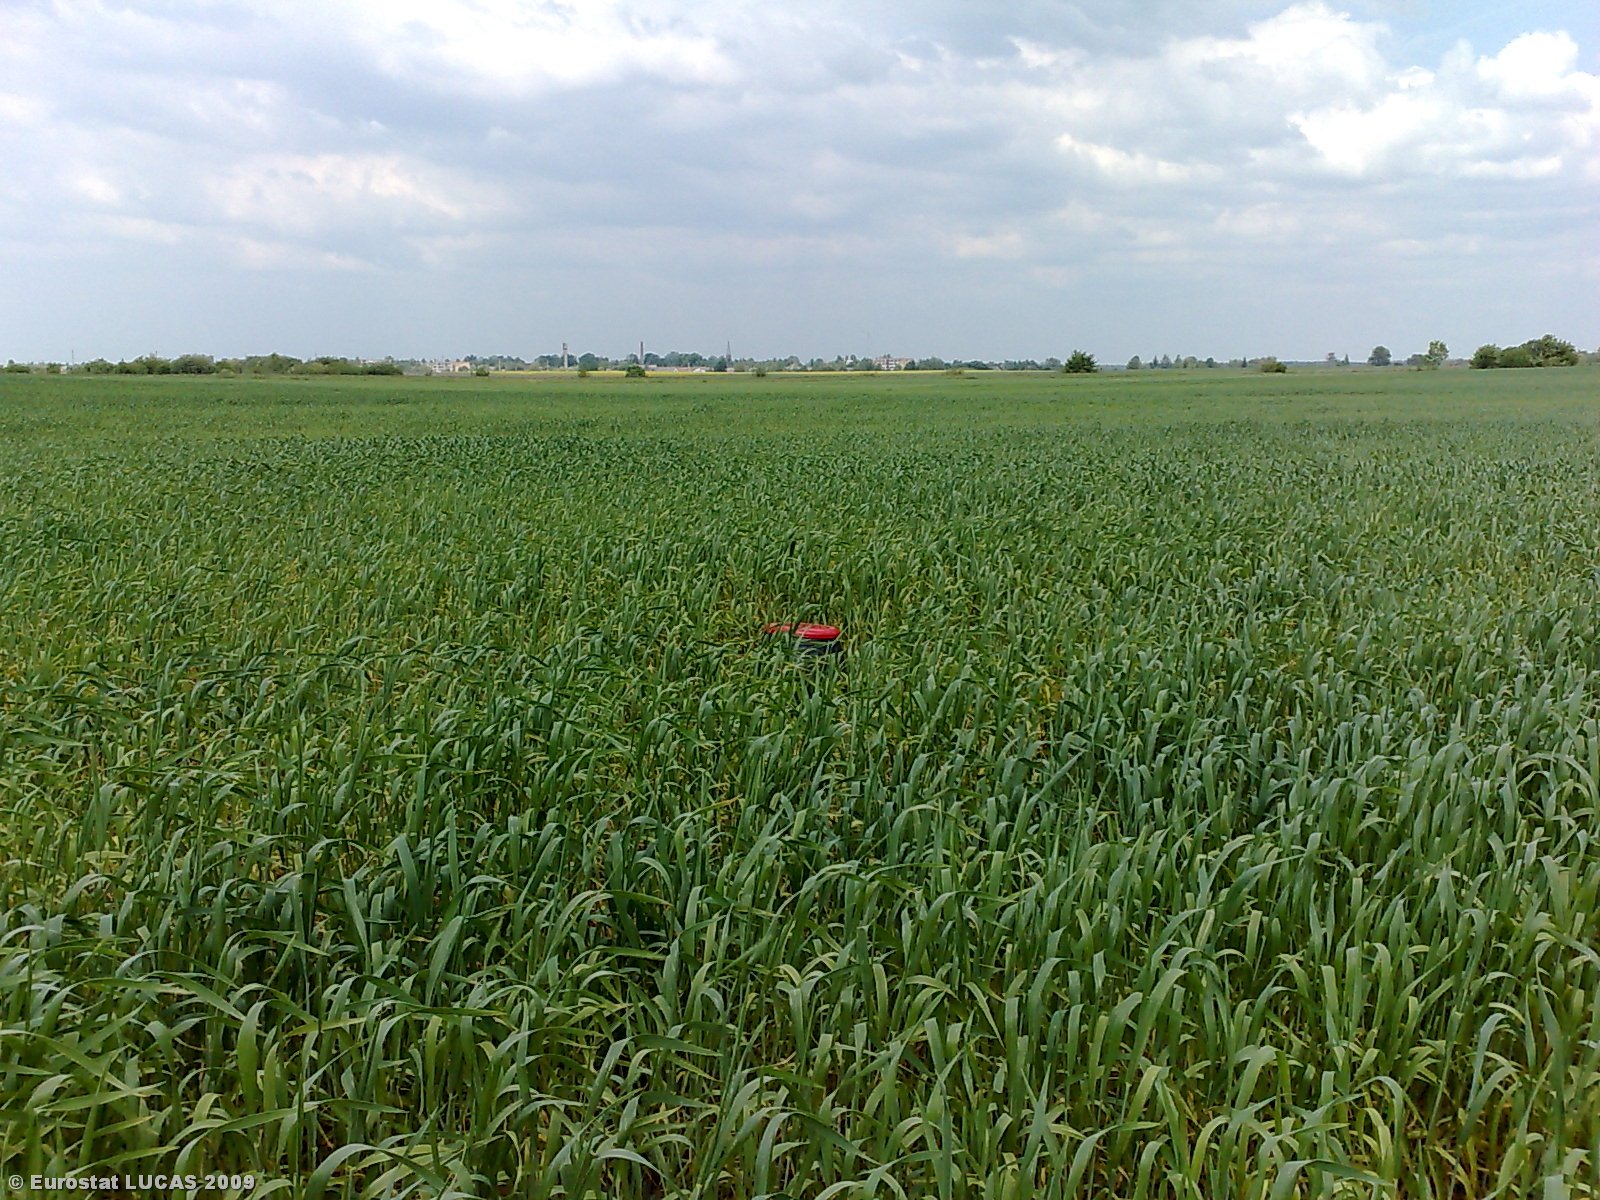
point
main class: Cropland
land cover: Common wheat
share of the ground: > 75 %
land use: Agriculture (excluding fallow land and kitchen gardens)
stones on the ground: < 10 %
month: May
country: LT
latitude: 56.2577
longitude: 23.9845
